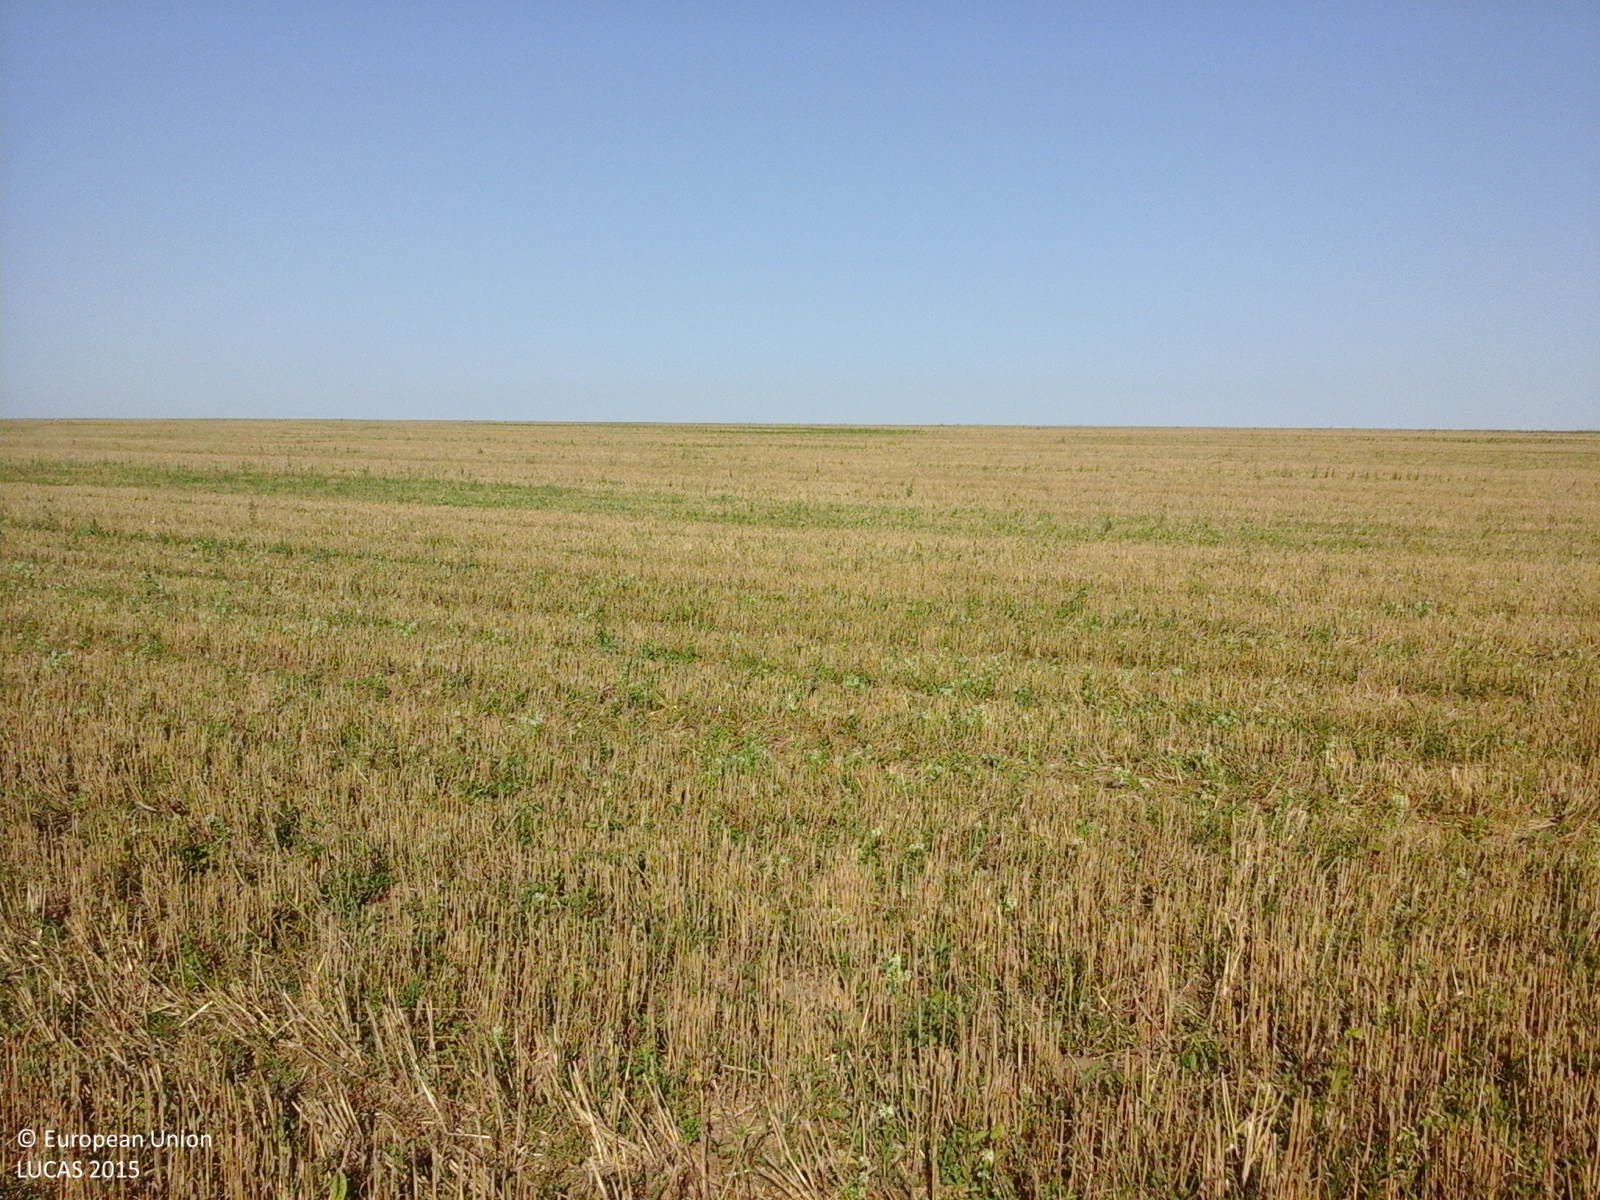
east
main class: Cropland
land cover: Common wheat
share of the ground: > 75 %
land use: Agriculture (excluding fallow land and kitchen gardens)
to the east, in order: Common wheat
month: August
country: RO
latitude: 44.3369
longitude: 28.3660
